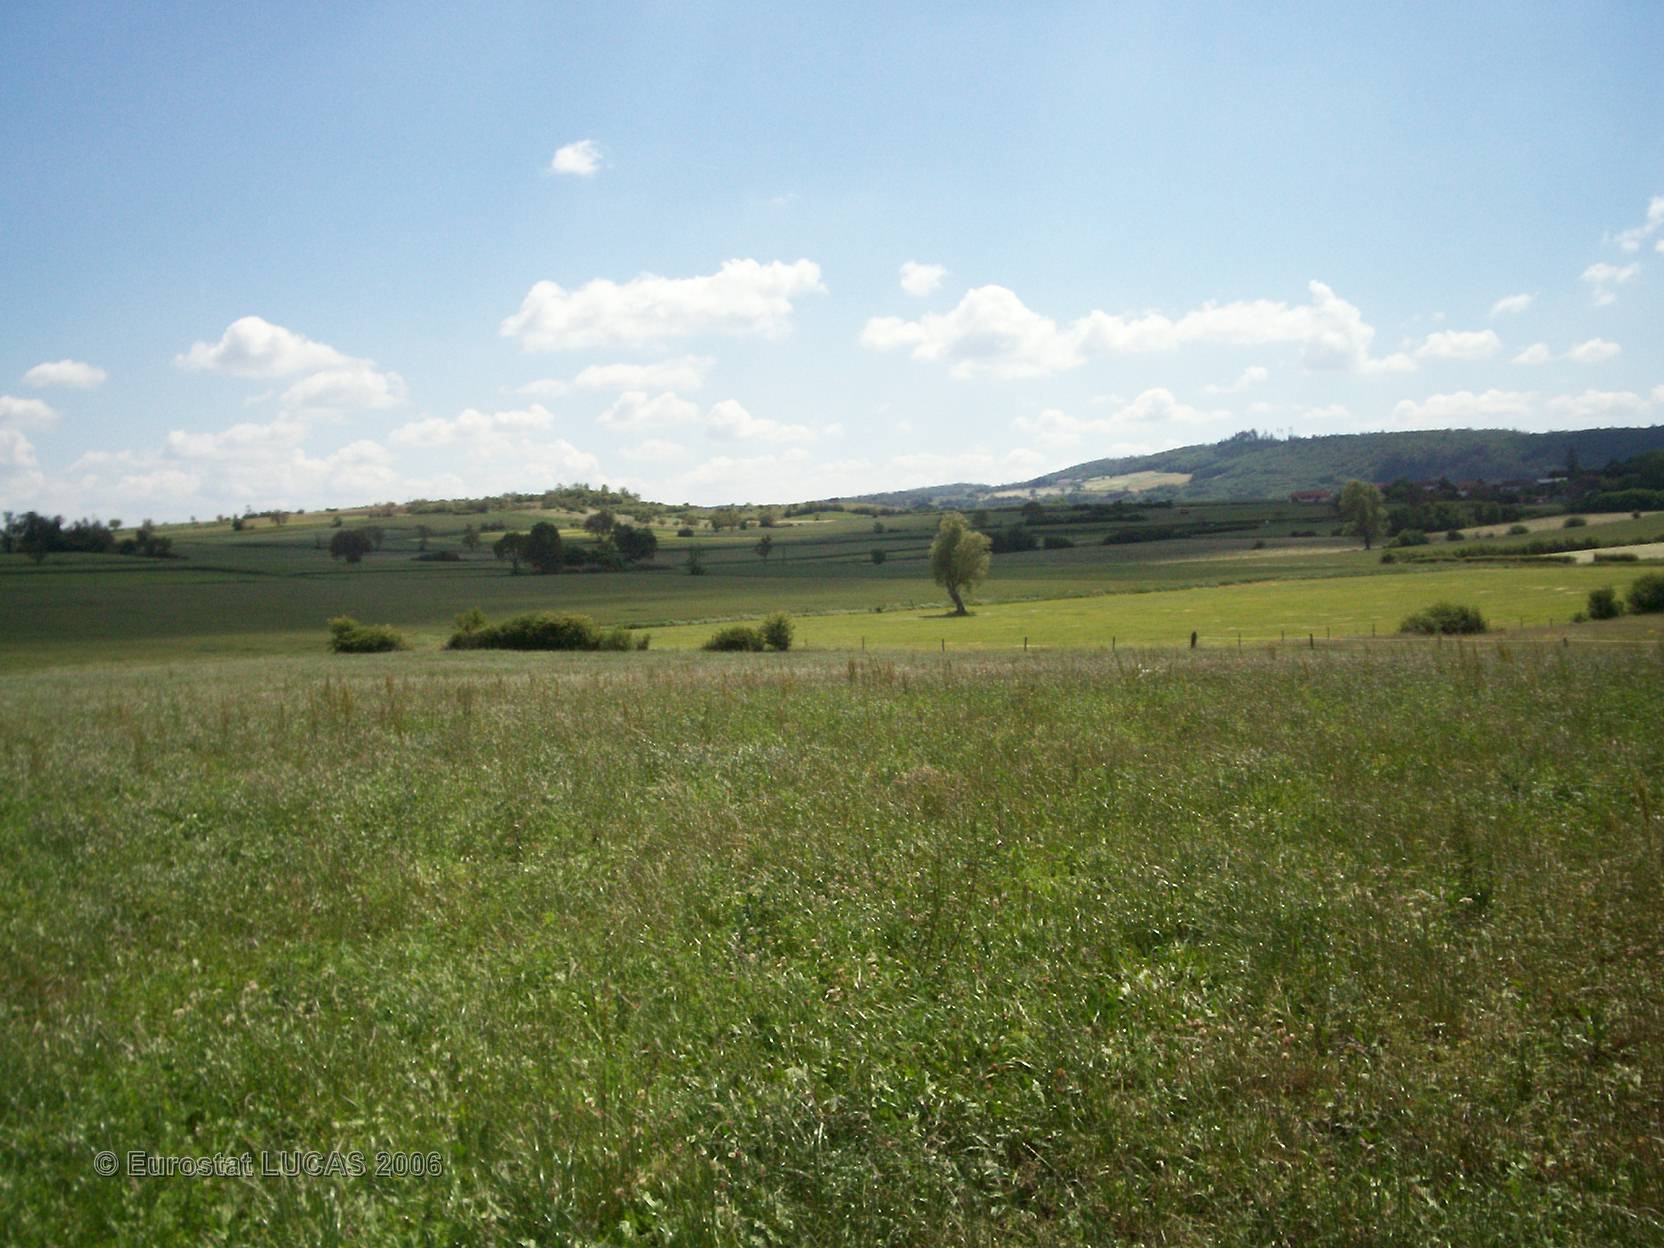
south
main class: Grassland
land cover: Grassland without tree/shrub cover
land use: Agriculture (excluding fallow land and kitchen gardens)
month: June
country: FR
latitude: 45.3474
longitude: 3.3267
